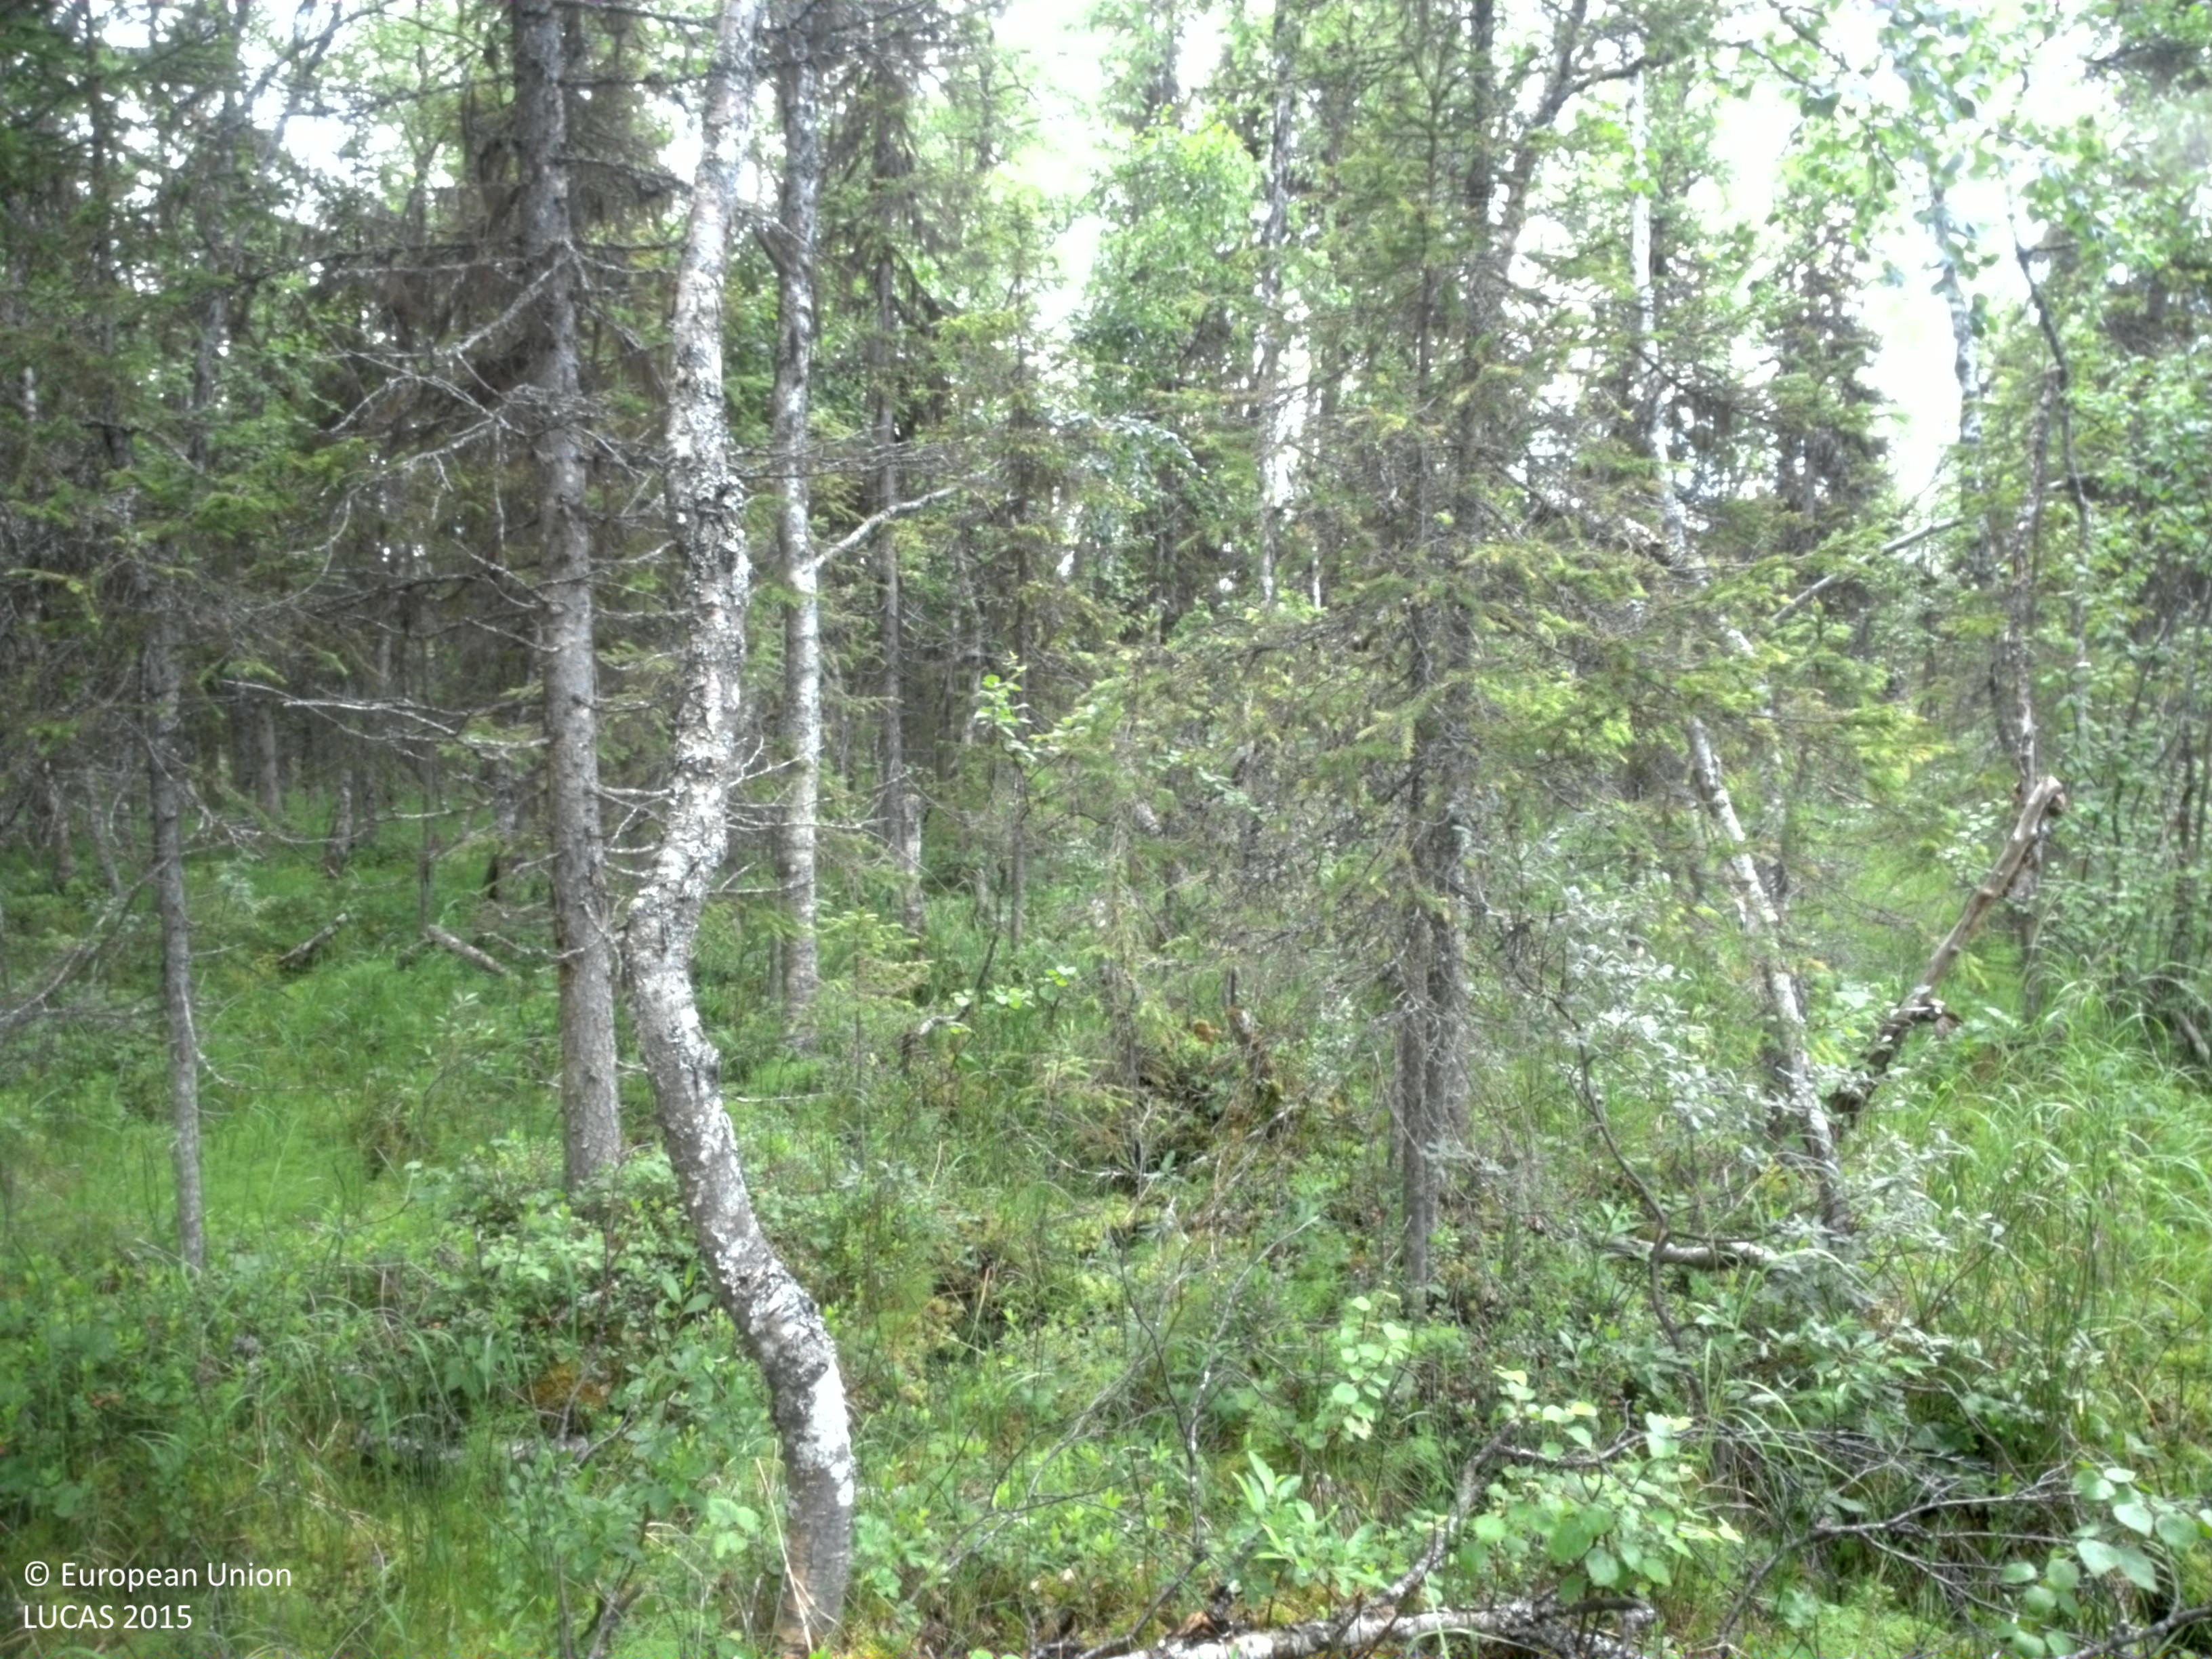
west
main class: Woodland
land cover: Spruce dominated mixed woodland
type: mire and swamp forests
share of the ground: 25 - 50 %
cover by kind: shrubs 45 %, coniferous forest trees 25 %, broadleaved forest trees 15 %, lichens and mosses 10 %, herbaceous plants 5 %
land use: Semi-natural and natural areas not in use
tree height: > 5 m
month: July
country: SE
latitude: 66.4246
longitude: 19.5657
